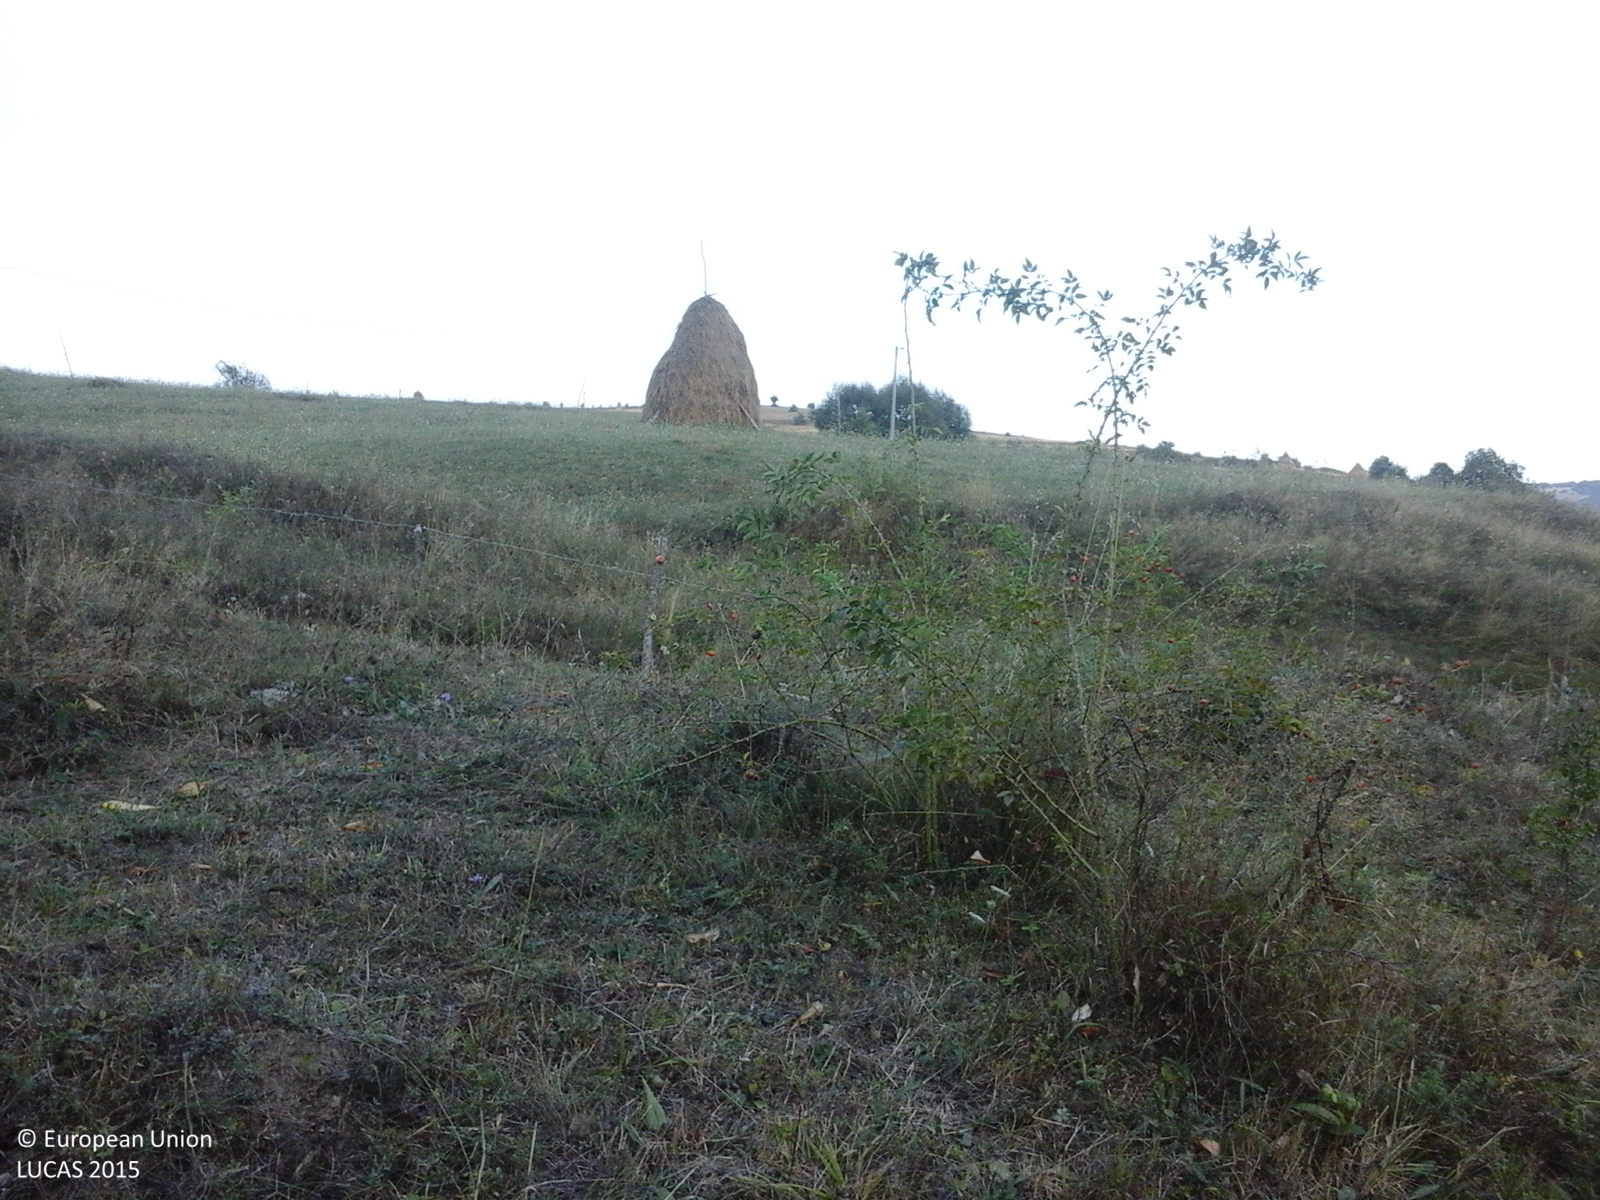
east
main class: Grassland
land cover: Grassland without tree/shrub cover
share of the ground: > 75 %
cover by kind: herbaceous plants 100 %
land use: Agriculture (excluding fallow land and kitchen gardens)
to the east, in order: Grassland without tree/shrub cover; Broadleaved woodland; Fences; Grassland with sparse tree/shrub cover; Tracks; Grassland without tree/shrub cover; Lucerne; Electric lines; Lucerne; Grassland without tree/shrub cover; Single bushes/trees; Grassland without tree/shrub cover; Lucerne
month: September
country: RO
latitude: 47.3546
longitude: 24.0503
